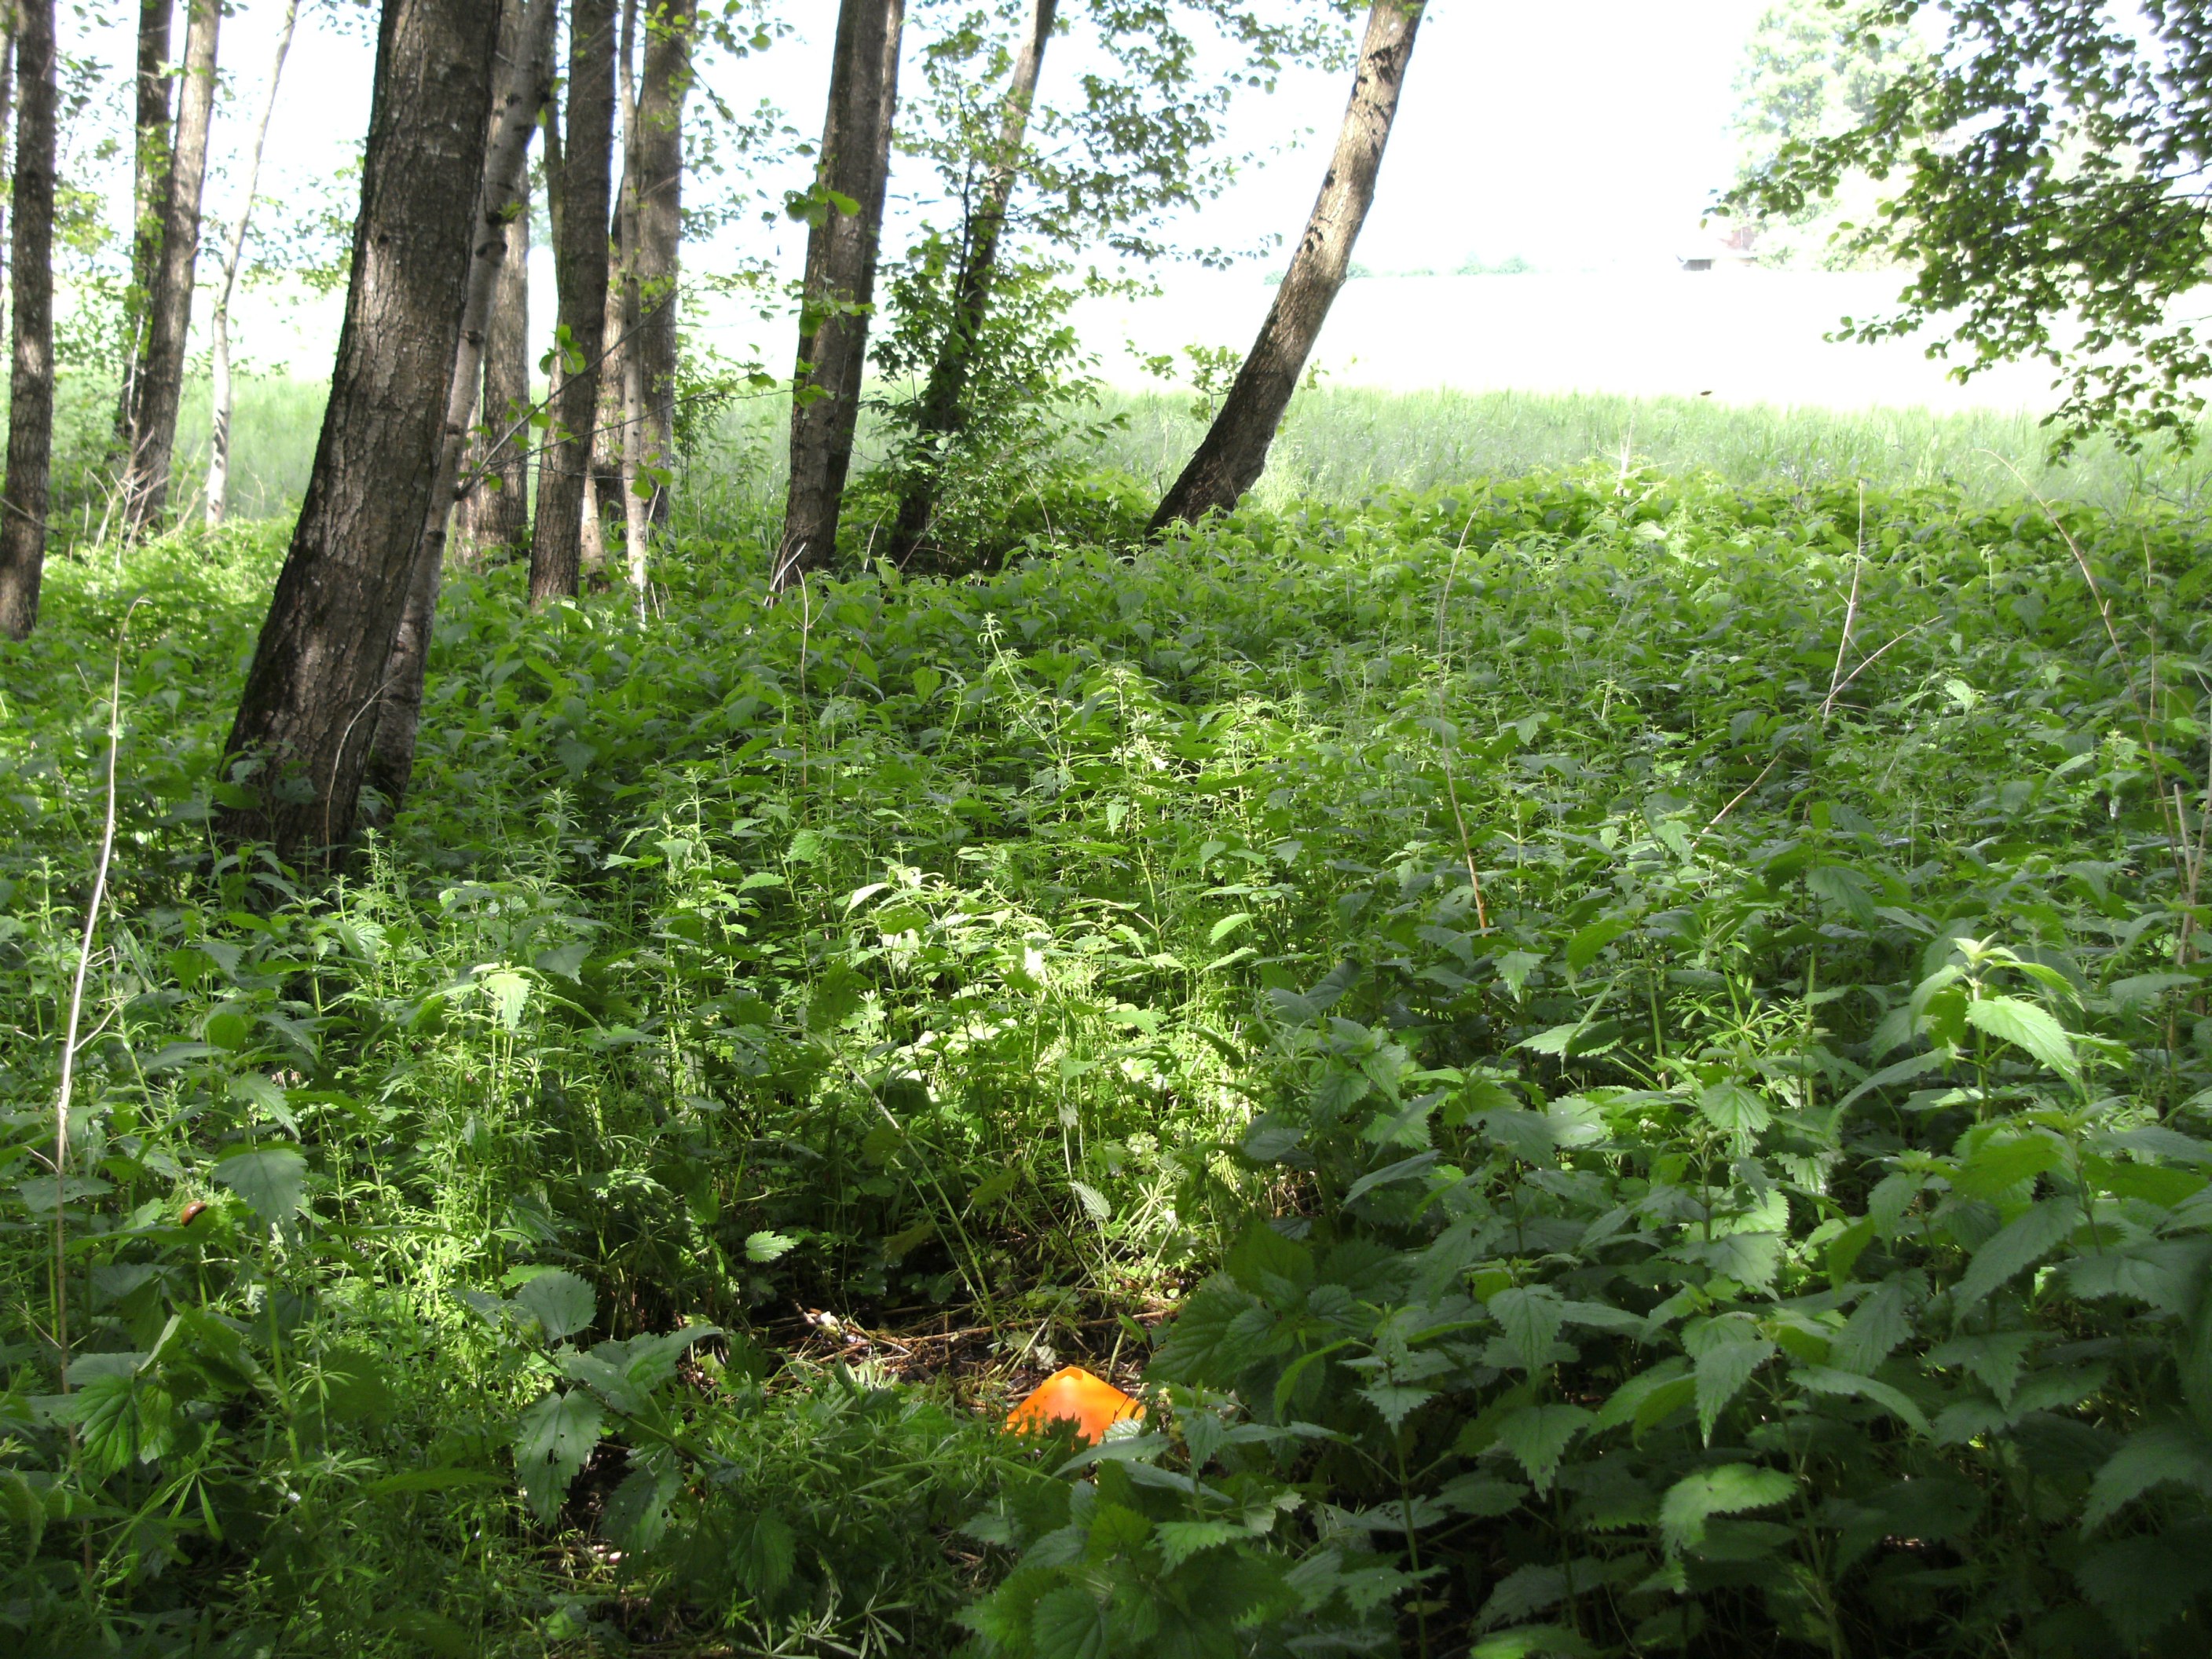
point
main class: Woodland
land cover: Broadleaved woodland
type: floodplain forest
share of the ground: > 75 %
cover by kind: broadleaved forest trees 85 %, shrubs 15 %
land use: Semi-natural and natural areas not in use
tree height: > 5 m
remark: Temporary flooded
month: May
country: AT
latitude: 48.2694
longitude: 13.7045
